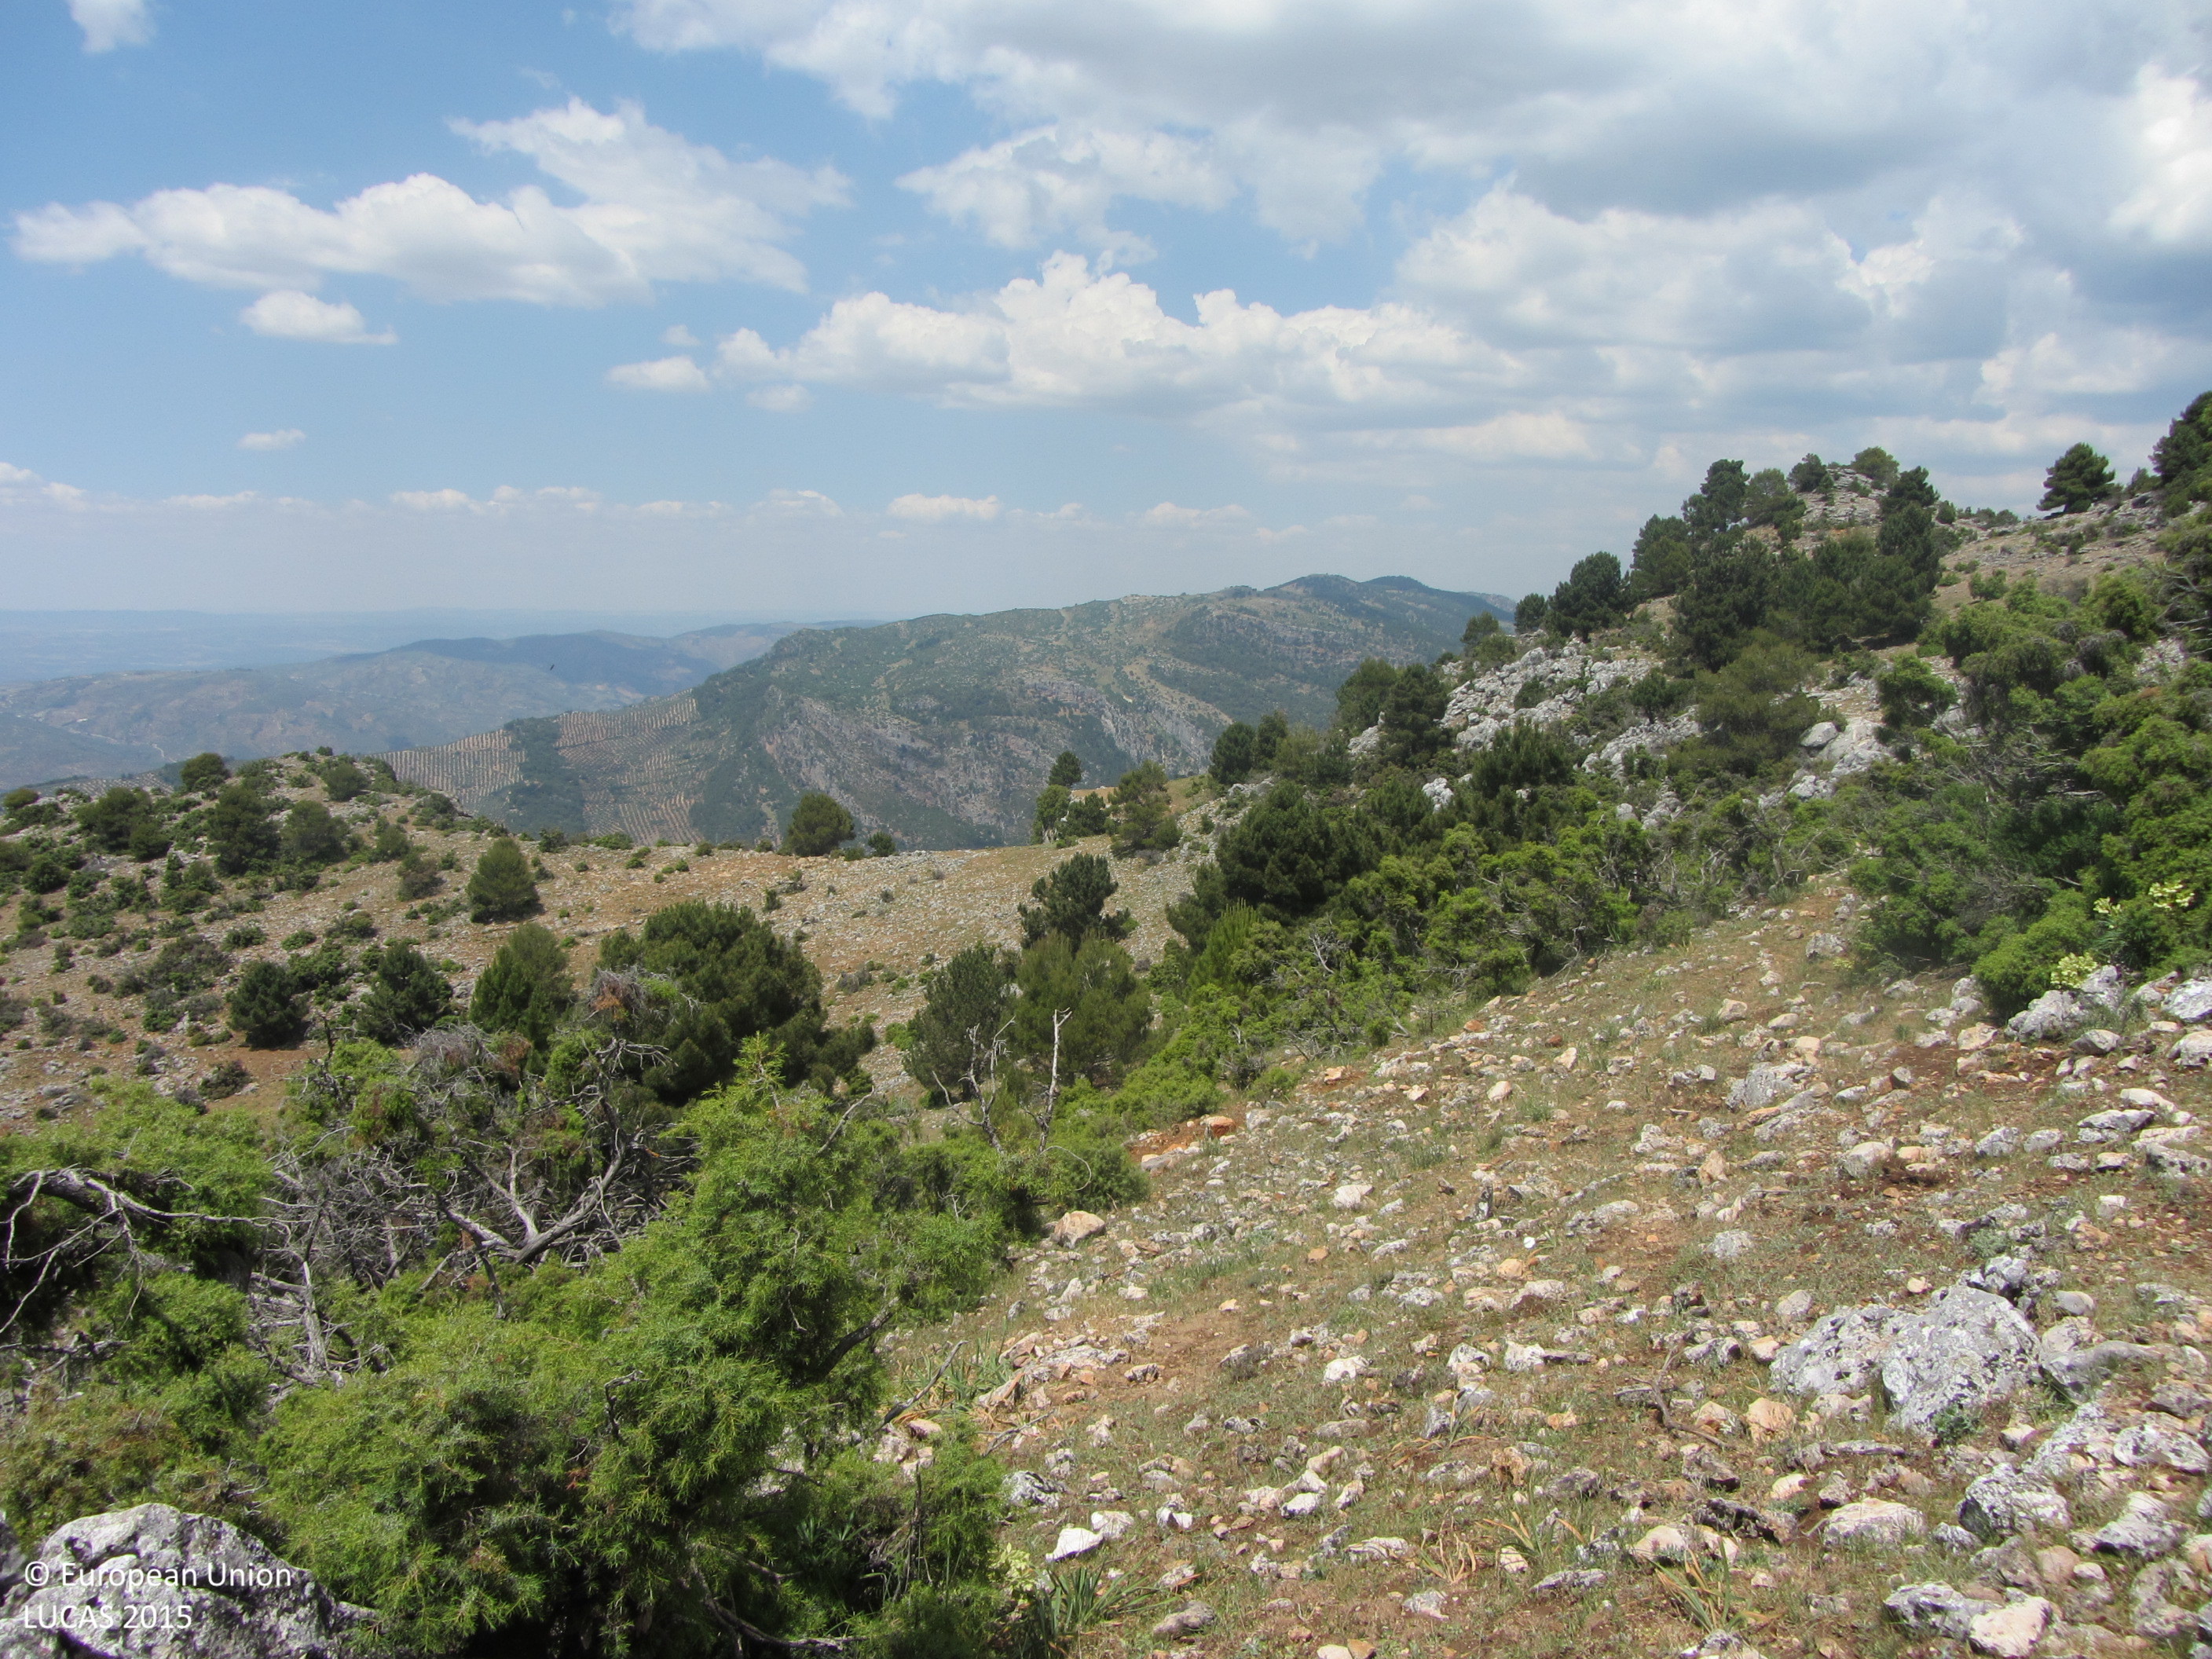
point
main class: Woodland
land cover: Pine dominated coniferous woodland
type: coniferous forest of the mediterranean region
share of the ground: 10 - 25 %
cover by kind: herbaceous plants 75 %, coniferous forest trees 15 %, consolidated bare surface 10 %
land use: Semi-natural and natural areas not in use
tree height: > 5 m
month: May
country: ES
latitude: 38.0672
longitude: -2.9569
